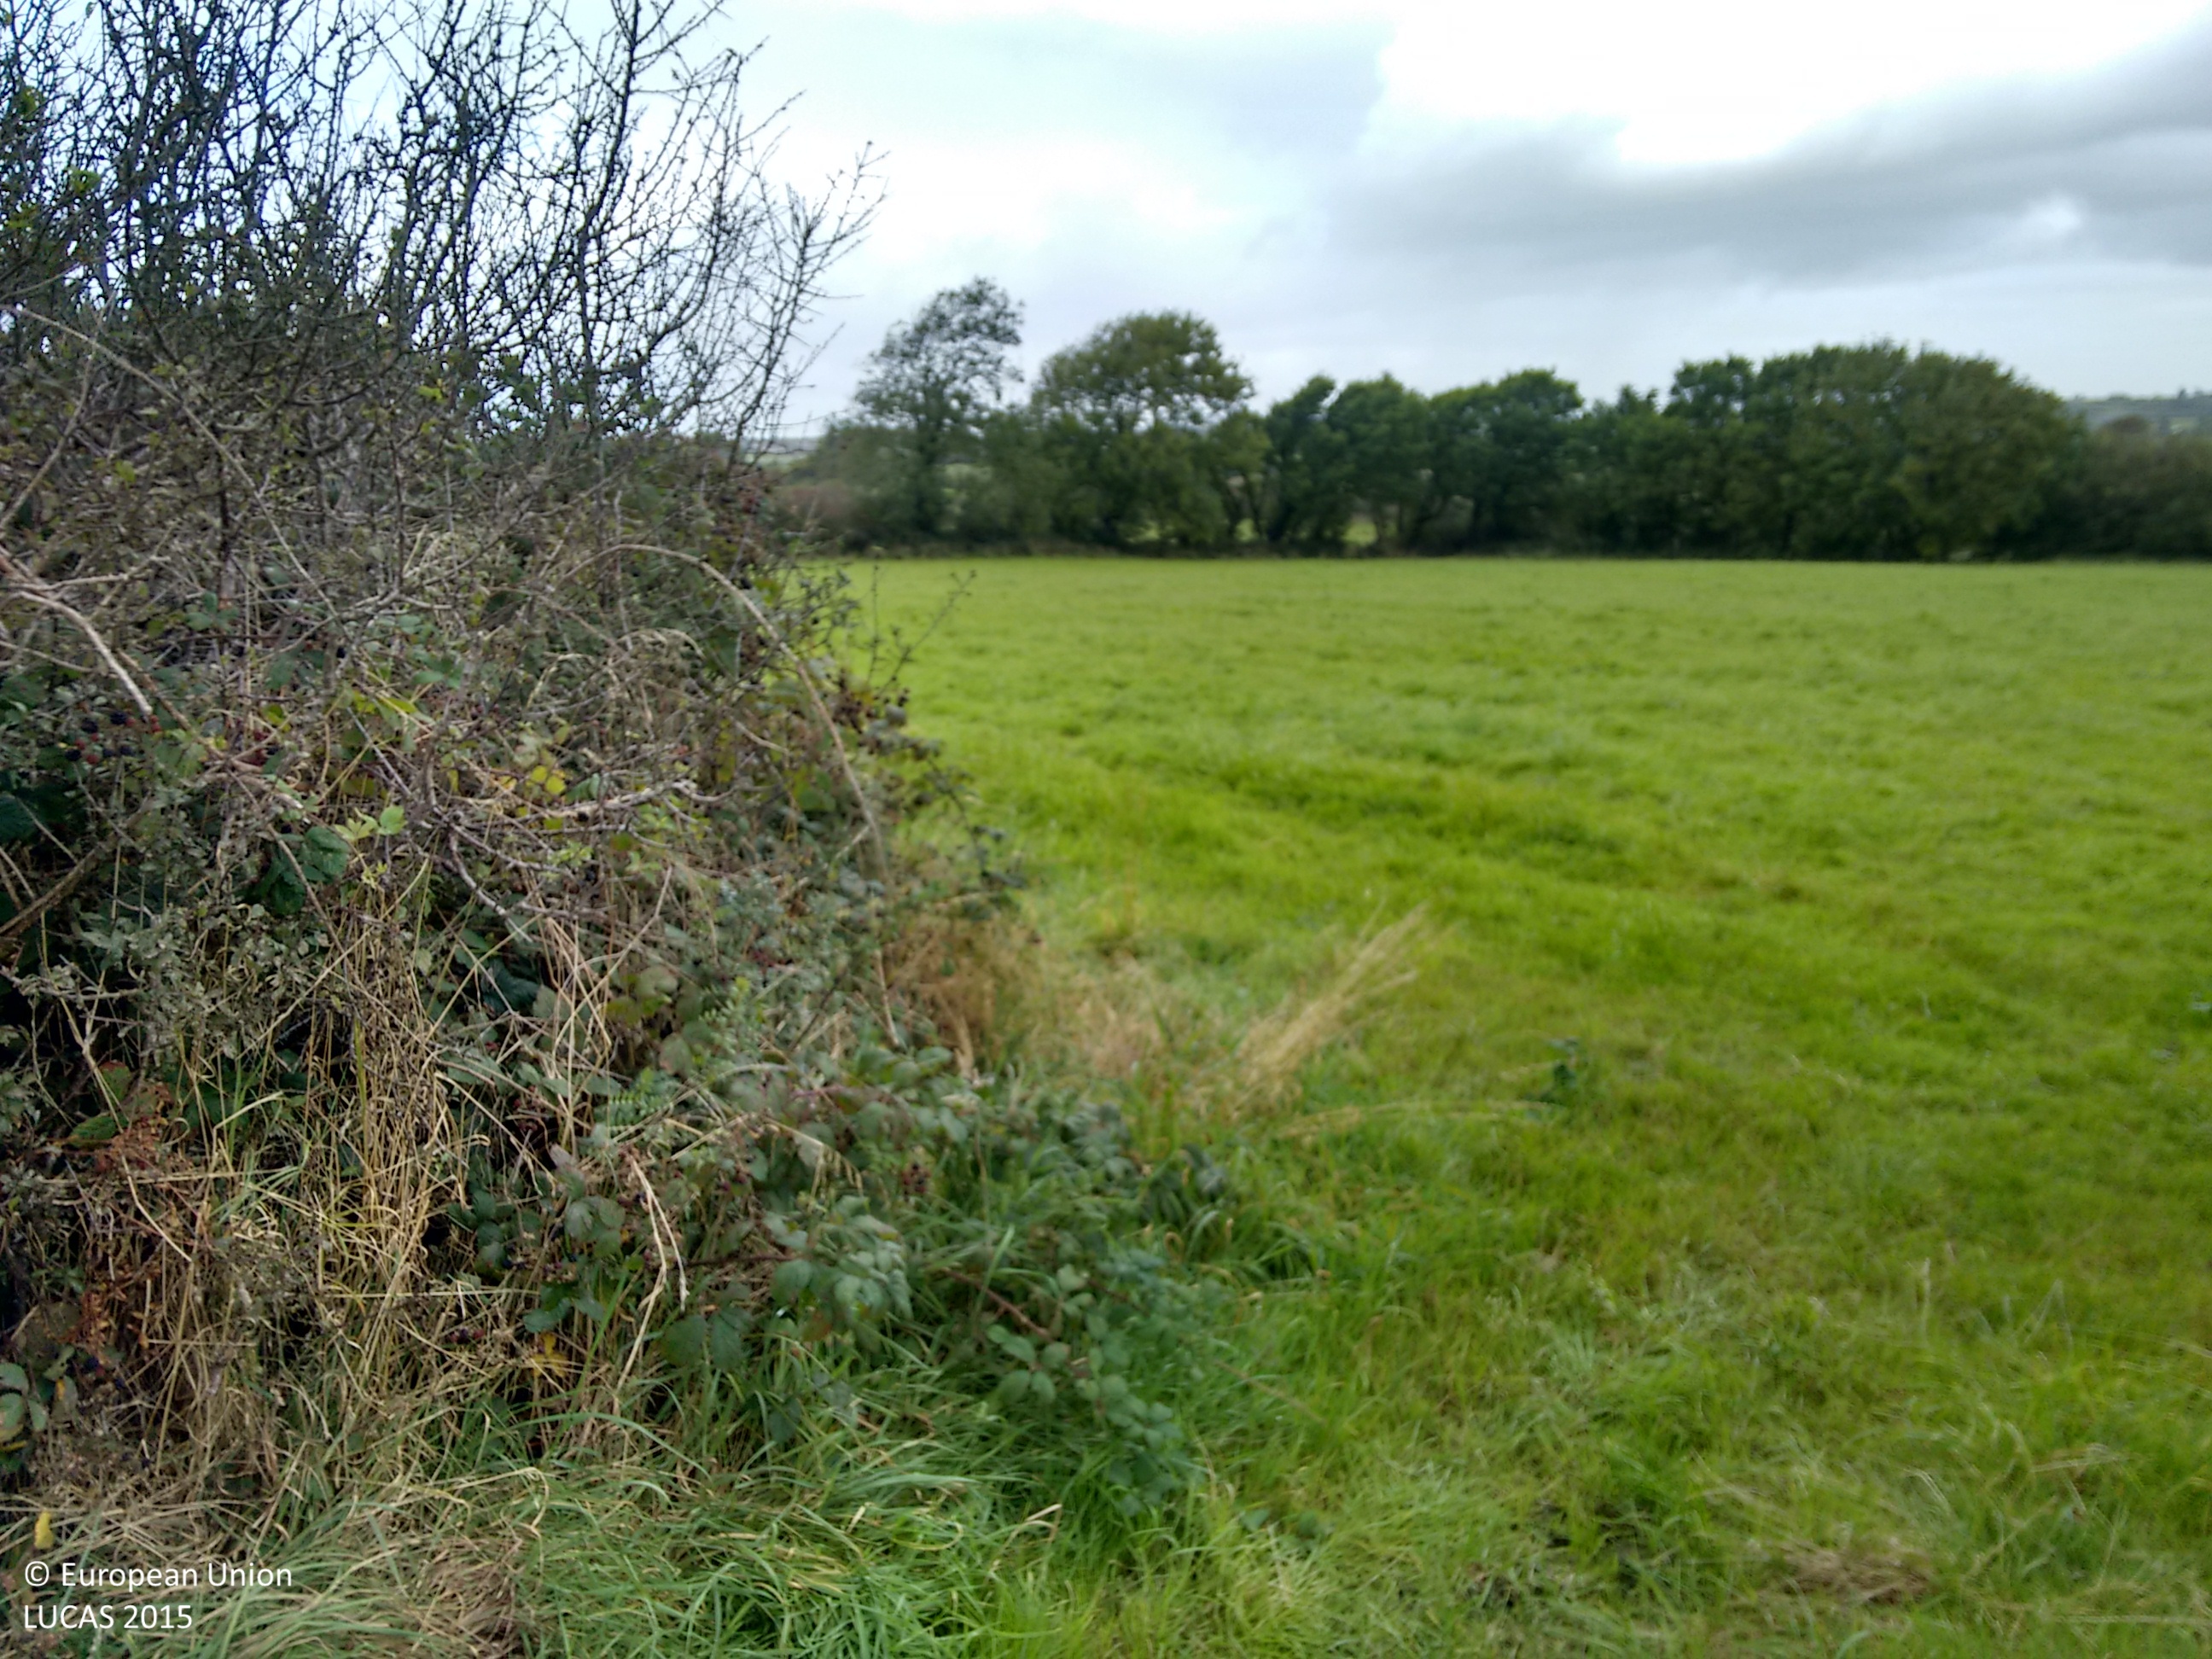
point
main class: Grassland
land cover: Grassland without tree/shrub cover
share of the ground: > 75 %
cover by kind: herbaceous plants 100 %
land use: Agriculture (excluding fallow land and kitchen gardens)
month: September
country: IE
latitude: 52.7348
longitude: -9.4081
